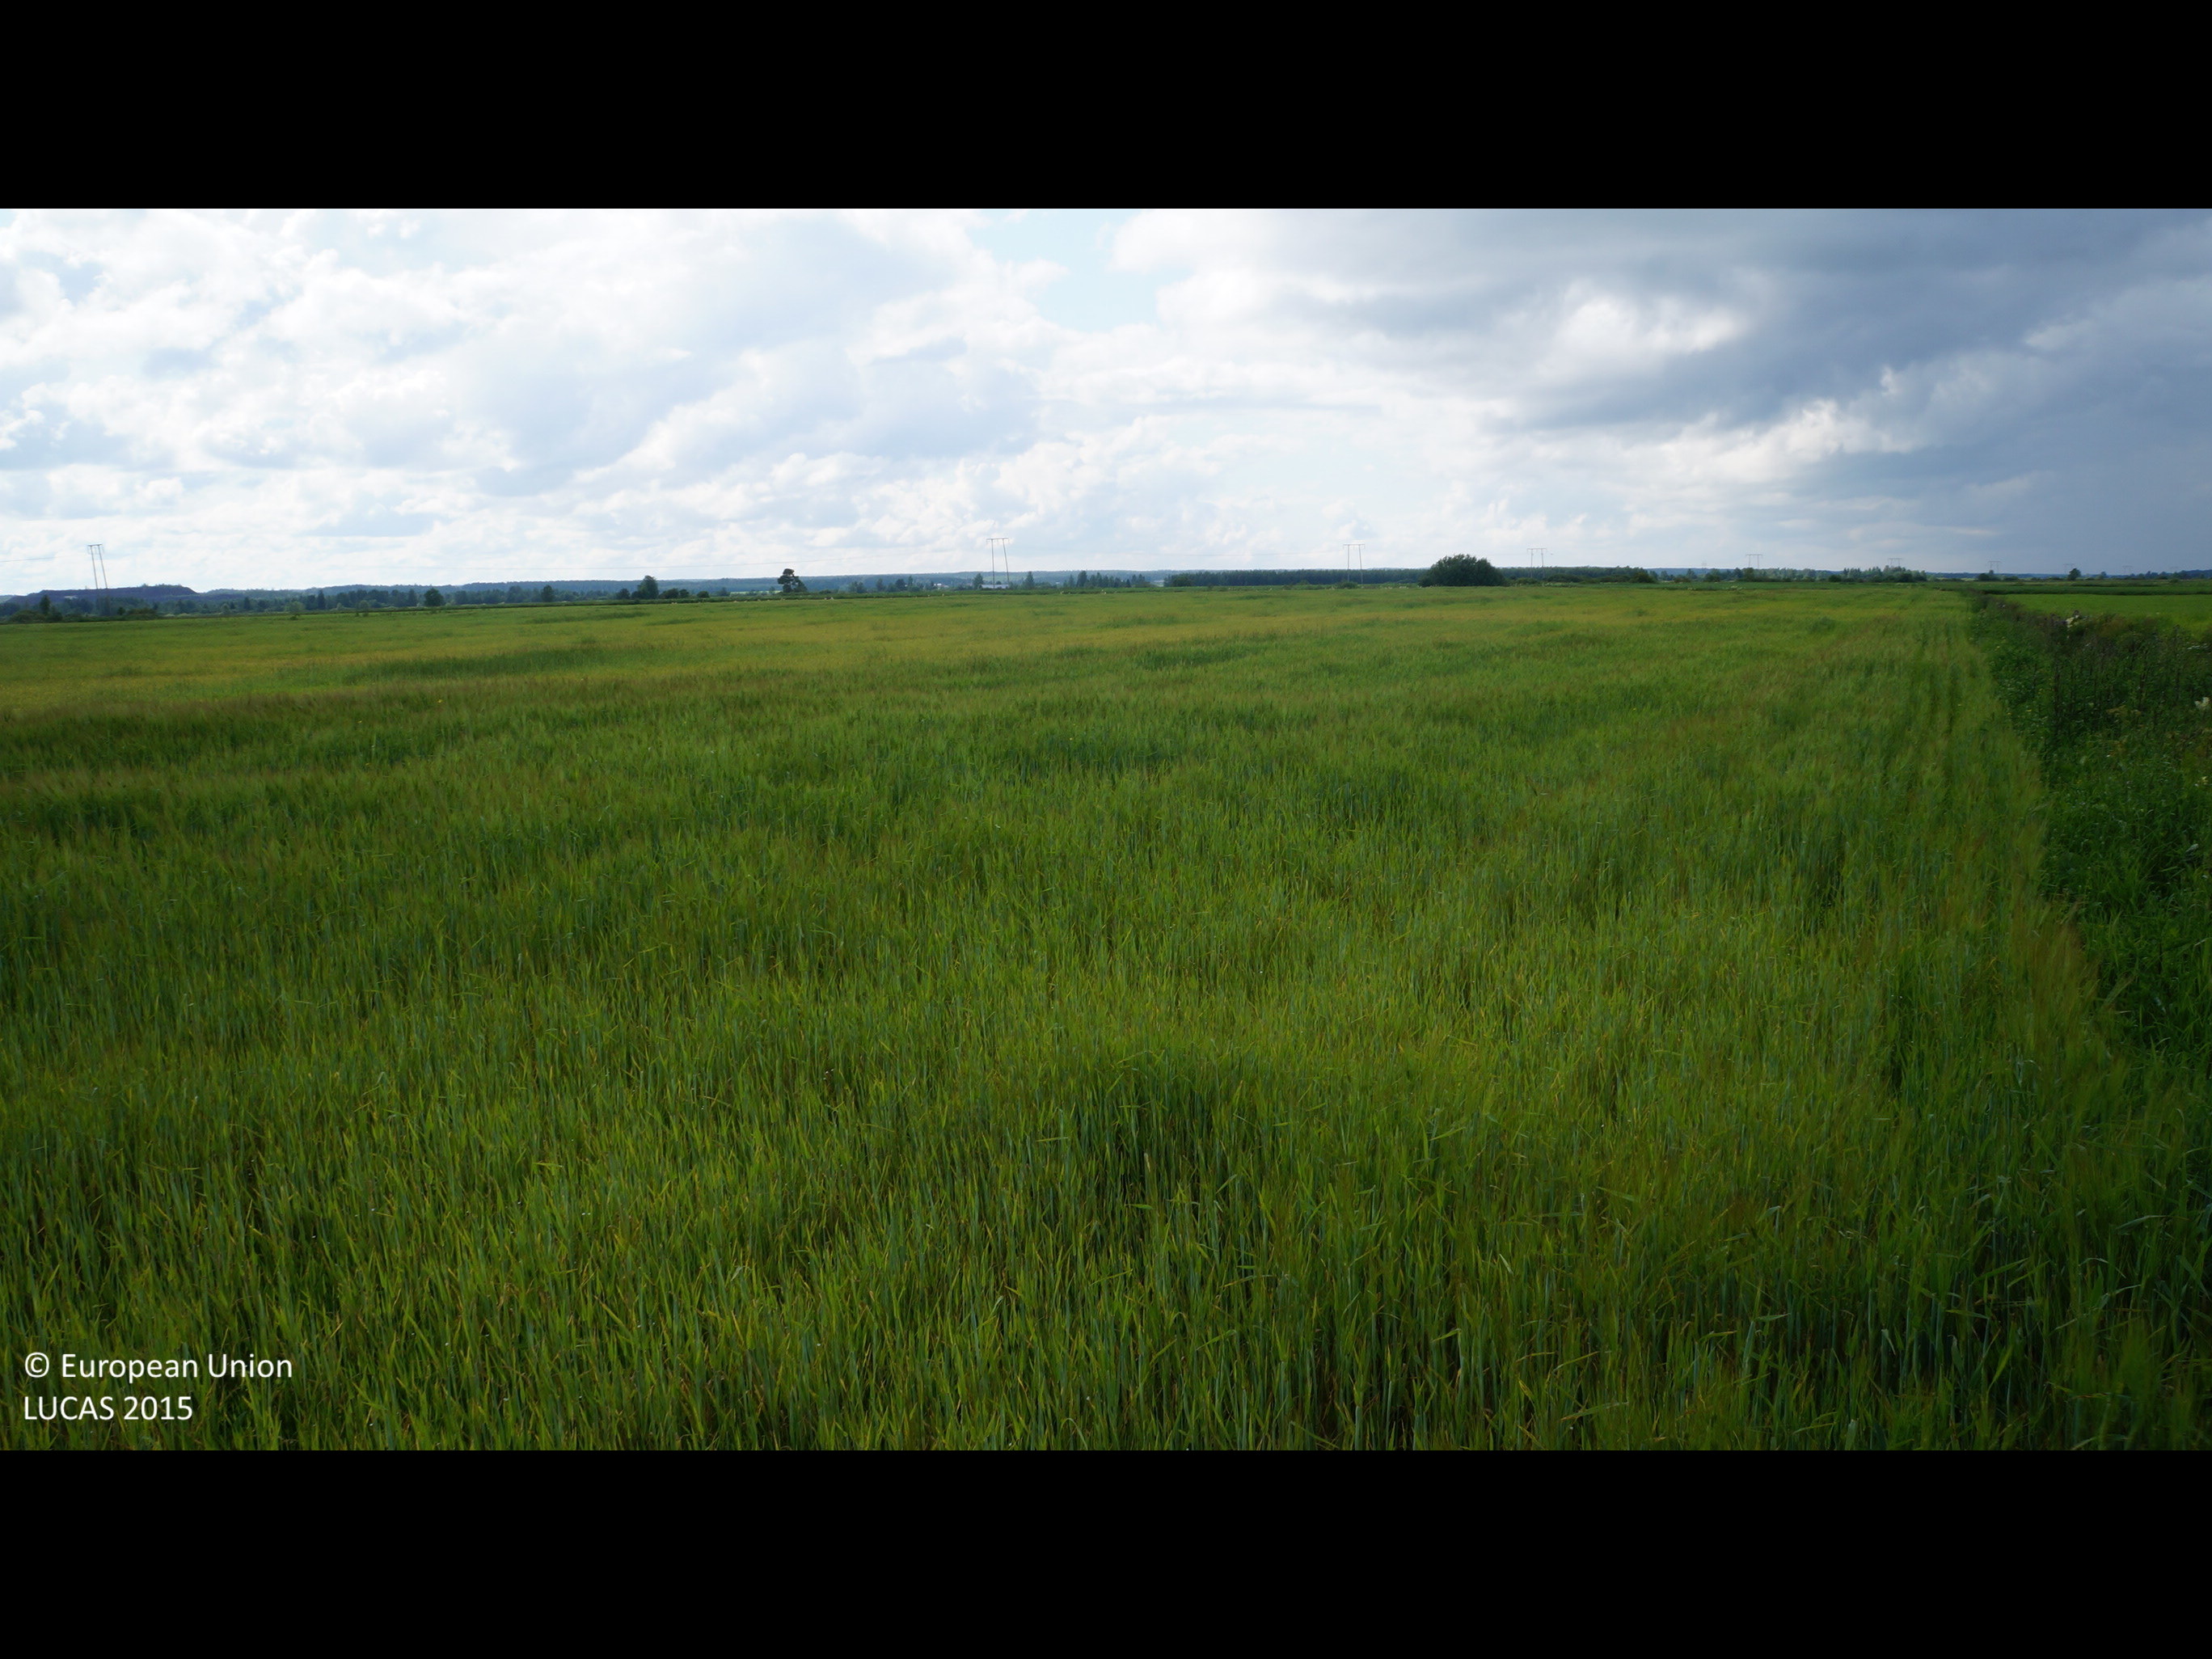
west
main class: Cropland
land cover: Barley
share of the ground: > 75 %
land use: Agriculture (excluding fallow land and kitchen gardens)
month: July
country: FI
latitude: 63.8562
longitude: 25.0797
